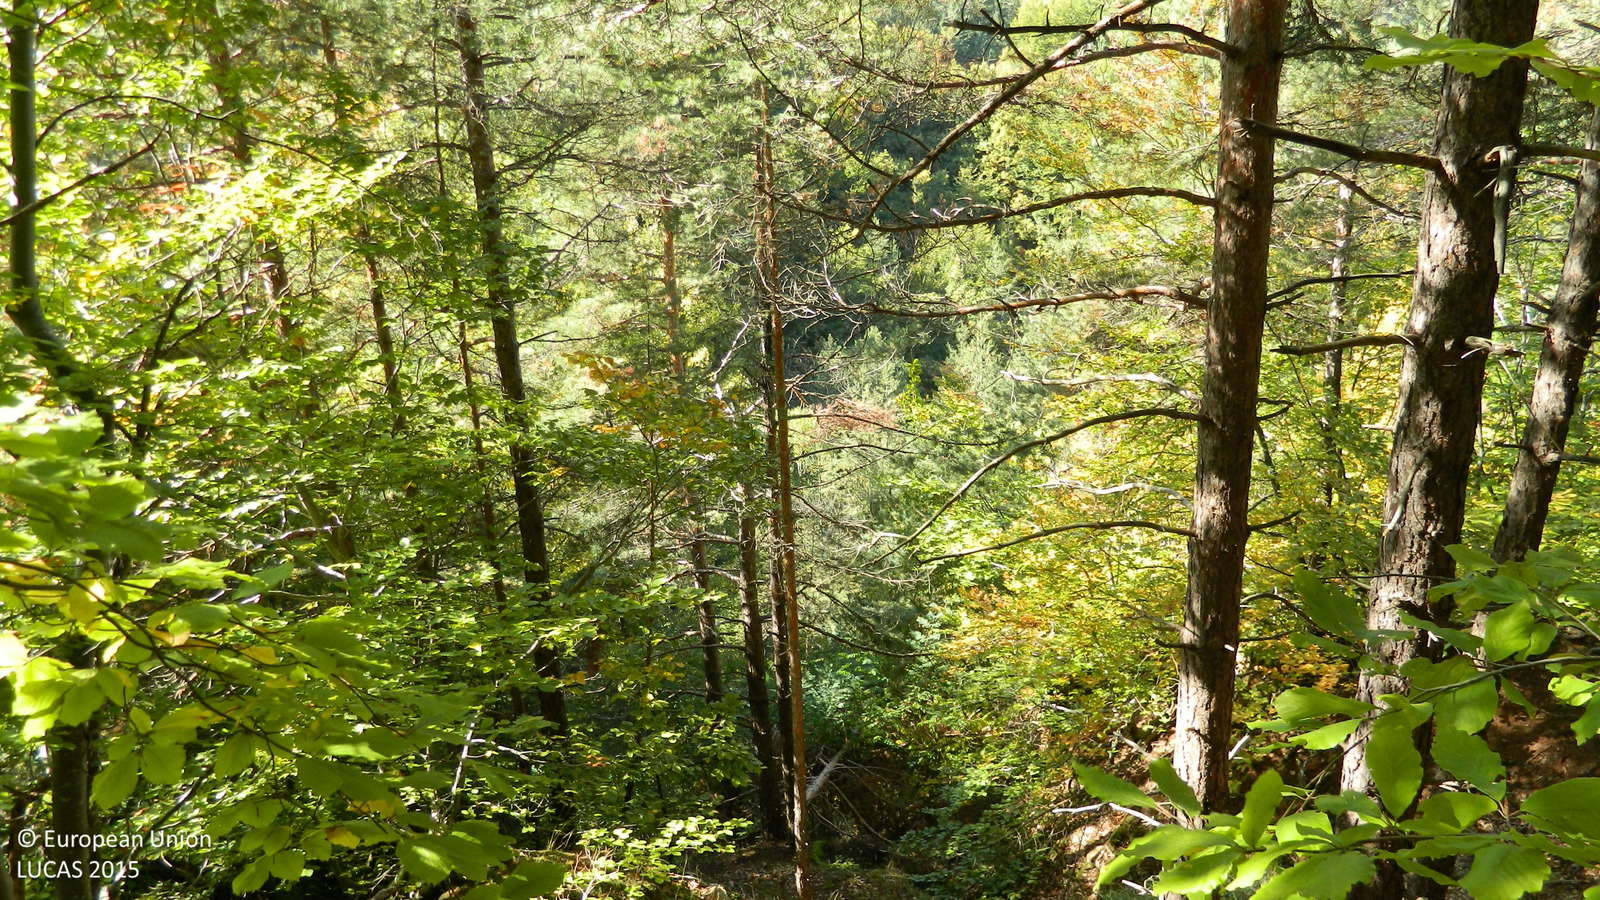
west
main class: Woodland
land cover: Pine dominated mixed woodland
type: hemiboreal forest and nemoral coniferous forest and mixed broadleaved-coniferous forest
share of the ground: > 75 %
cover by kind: coniferous forest trees 55 %, broadleaved forest trees 45 %
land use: Forestry
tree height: > 5 m
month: October
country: BG
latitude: 41.6684
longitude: 25.0525
